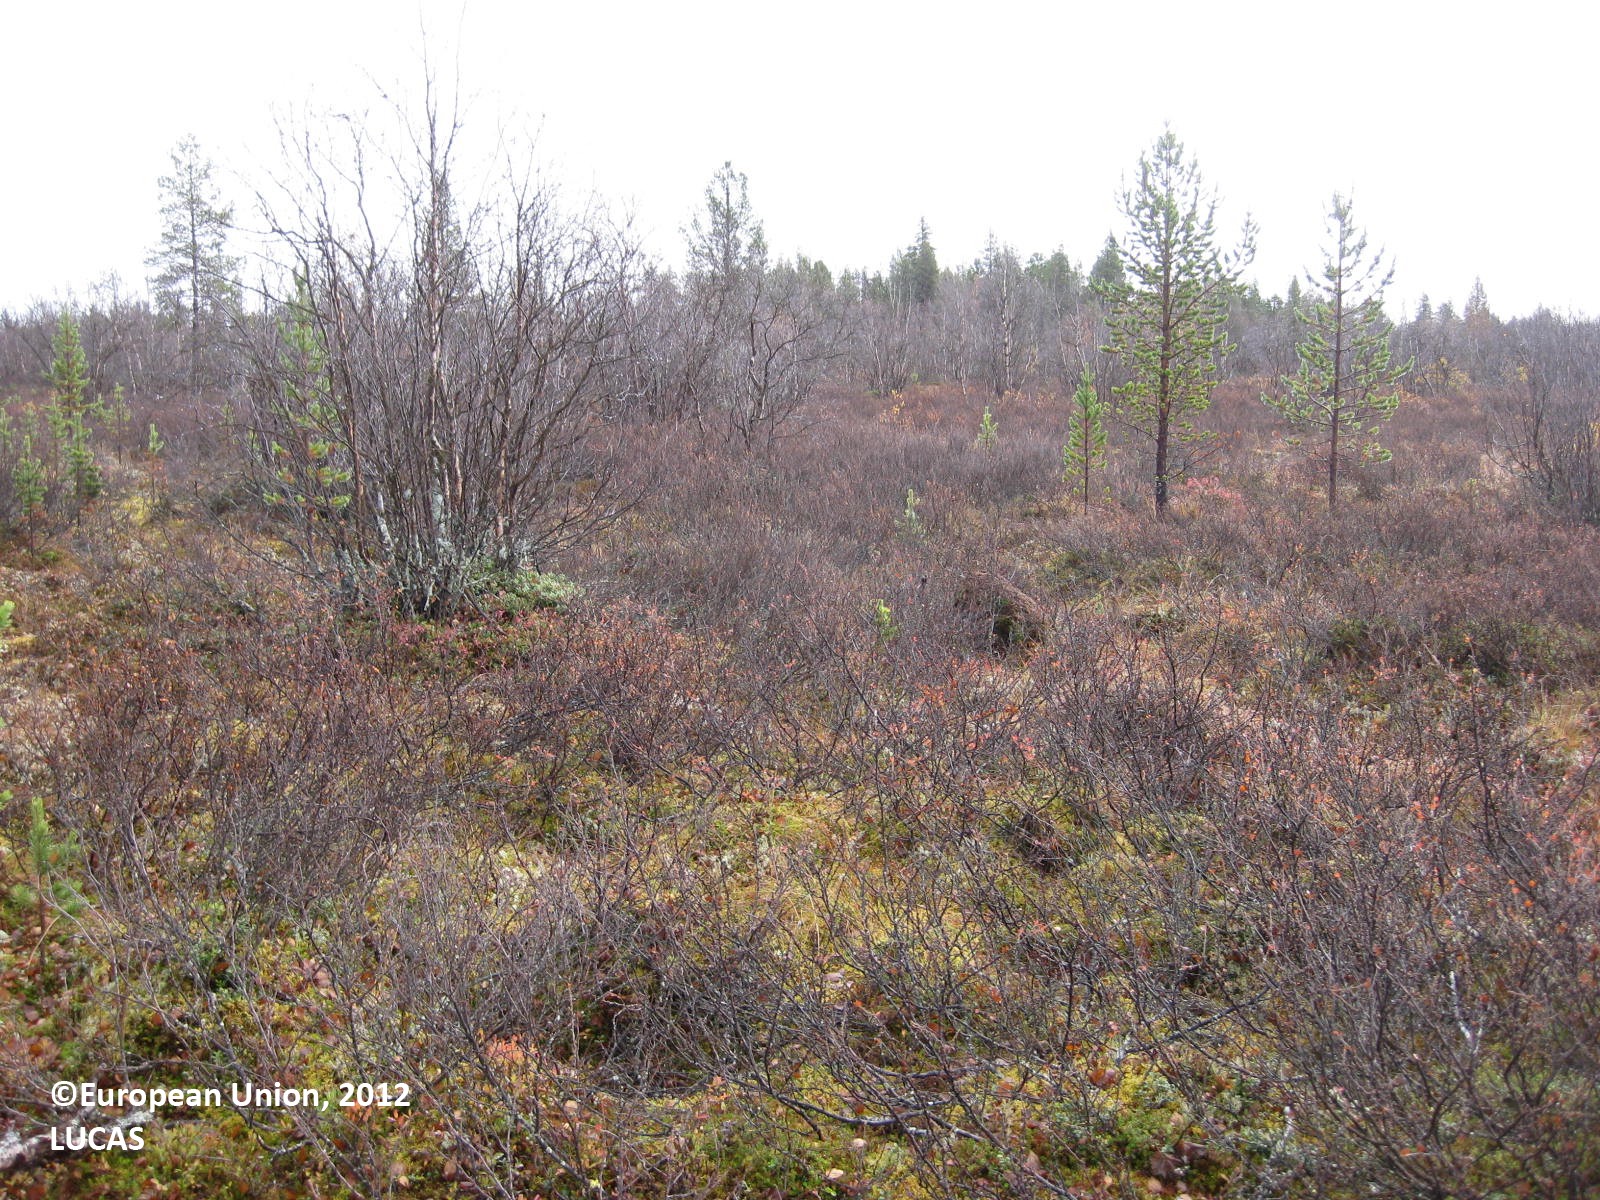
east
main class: Woodland
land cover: Pine dominated mixed woodland
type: boreal forest
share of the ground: 50 - 75 %
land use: Semi-natural and natural areas not in use
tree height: > 5 m
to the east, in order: Pine dominated mixed woodland; Broadleaved woodland; Pine dominated mixed woodland
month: September
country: FI
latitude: 68.3999
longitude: 24.3028
